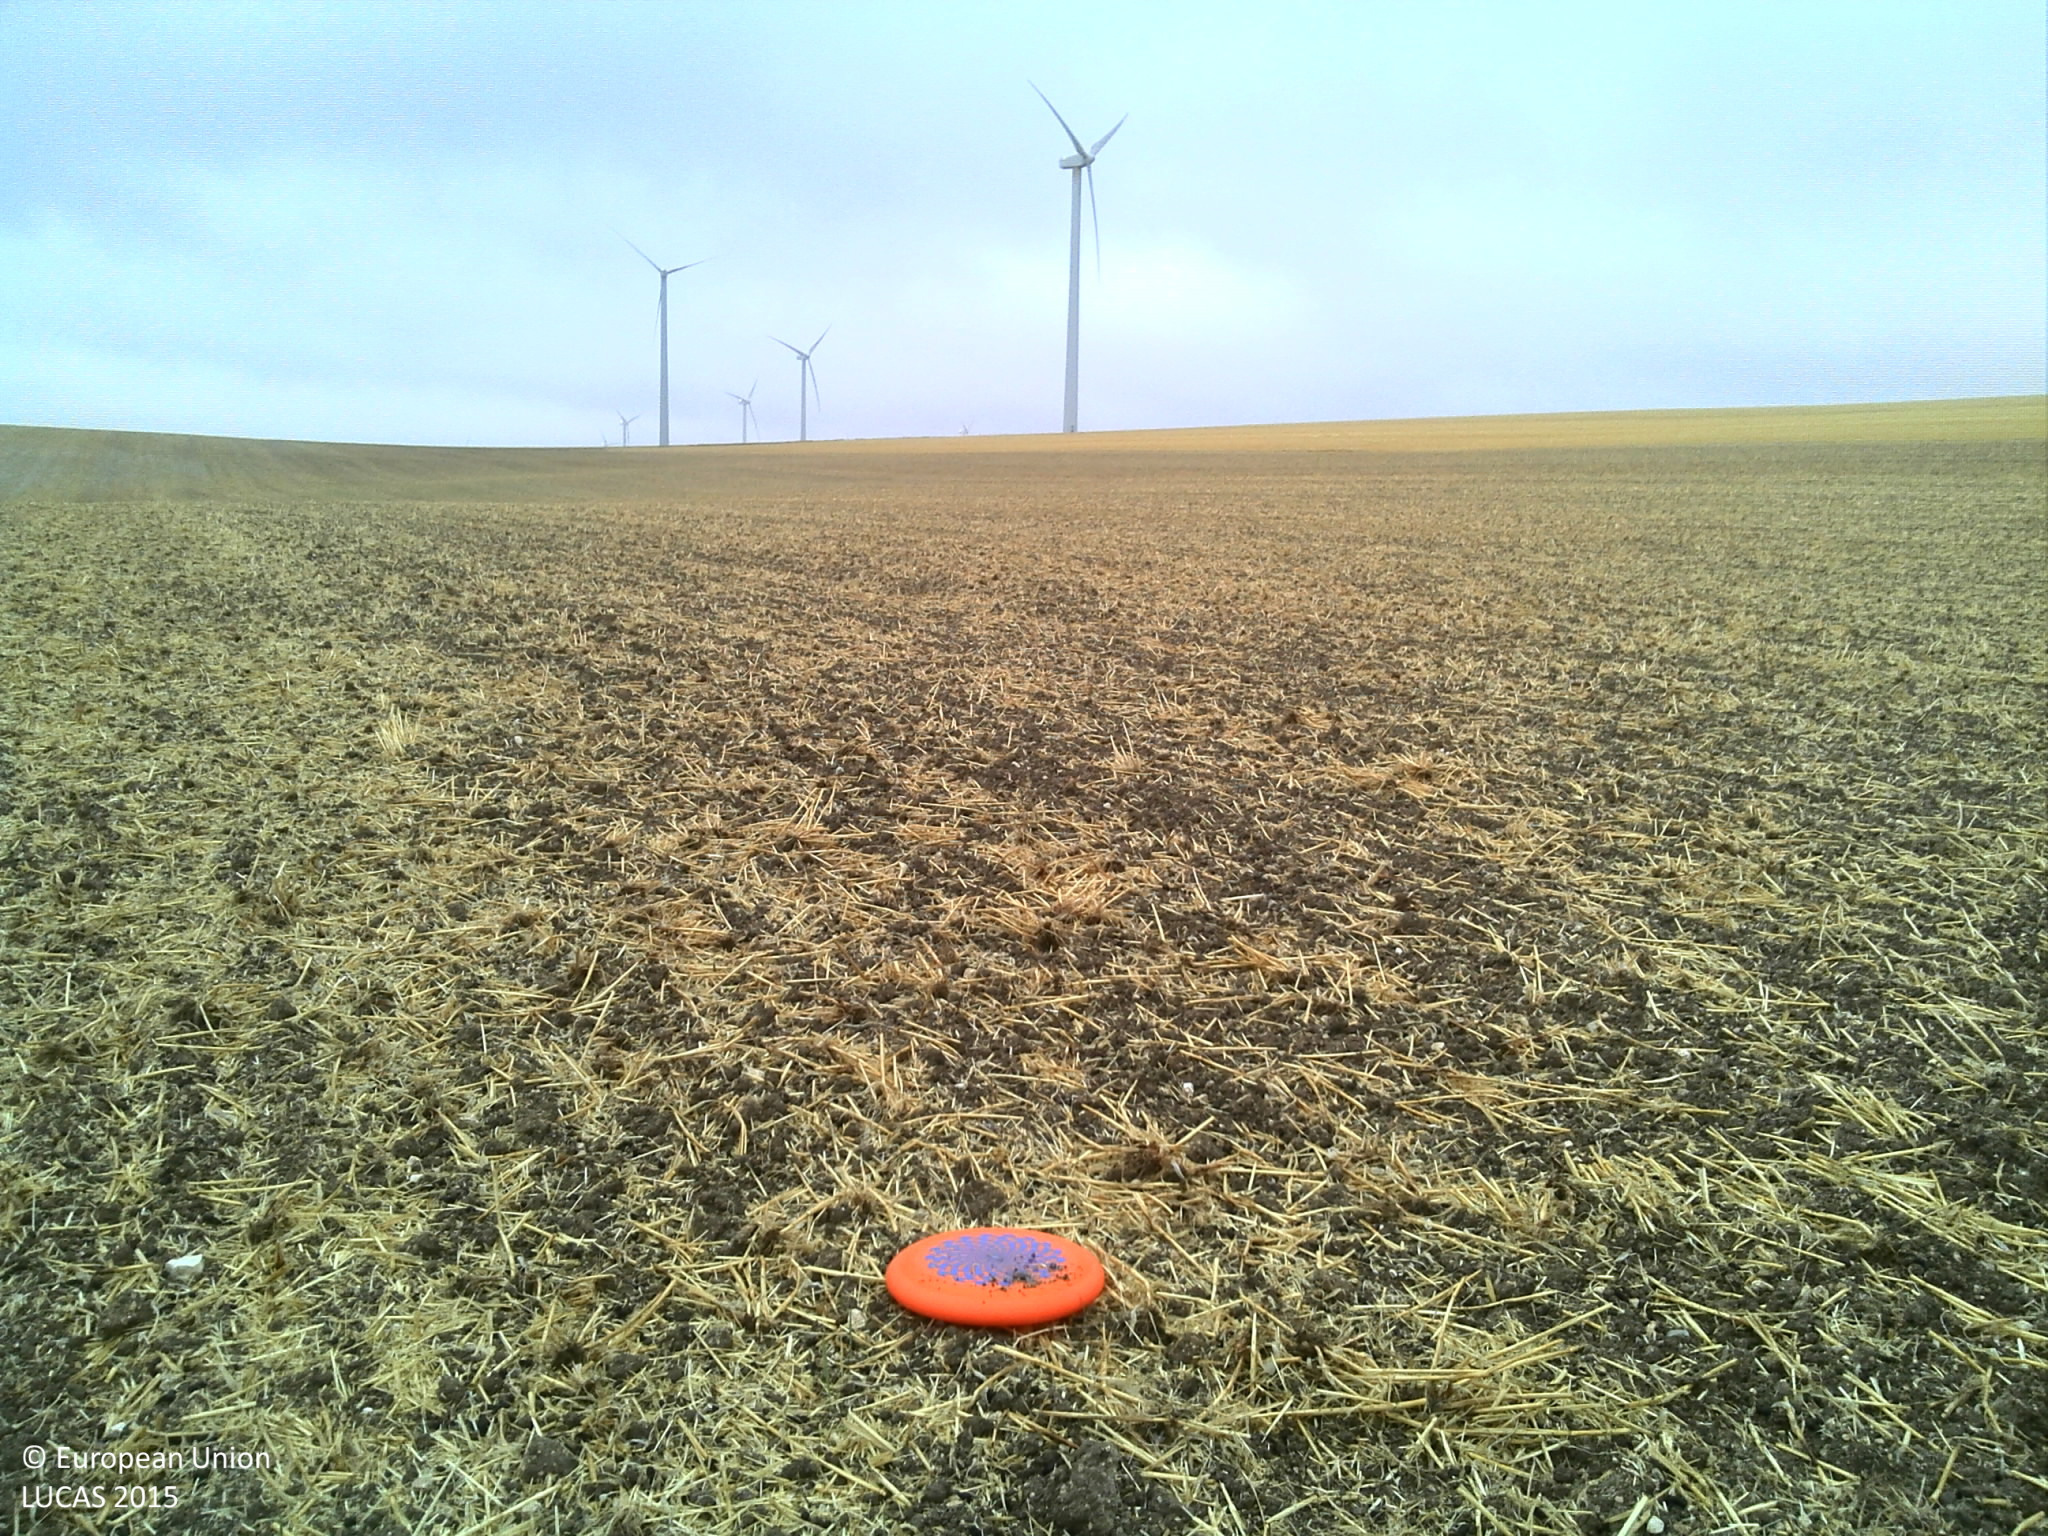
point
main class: Cropland
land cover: Common wheat
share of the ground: > 75 %
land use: Agriculture (excluding fallow land and kitchen gardens)
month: August
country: FR
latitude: 48.8326
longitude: 4.6433
